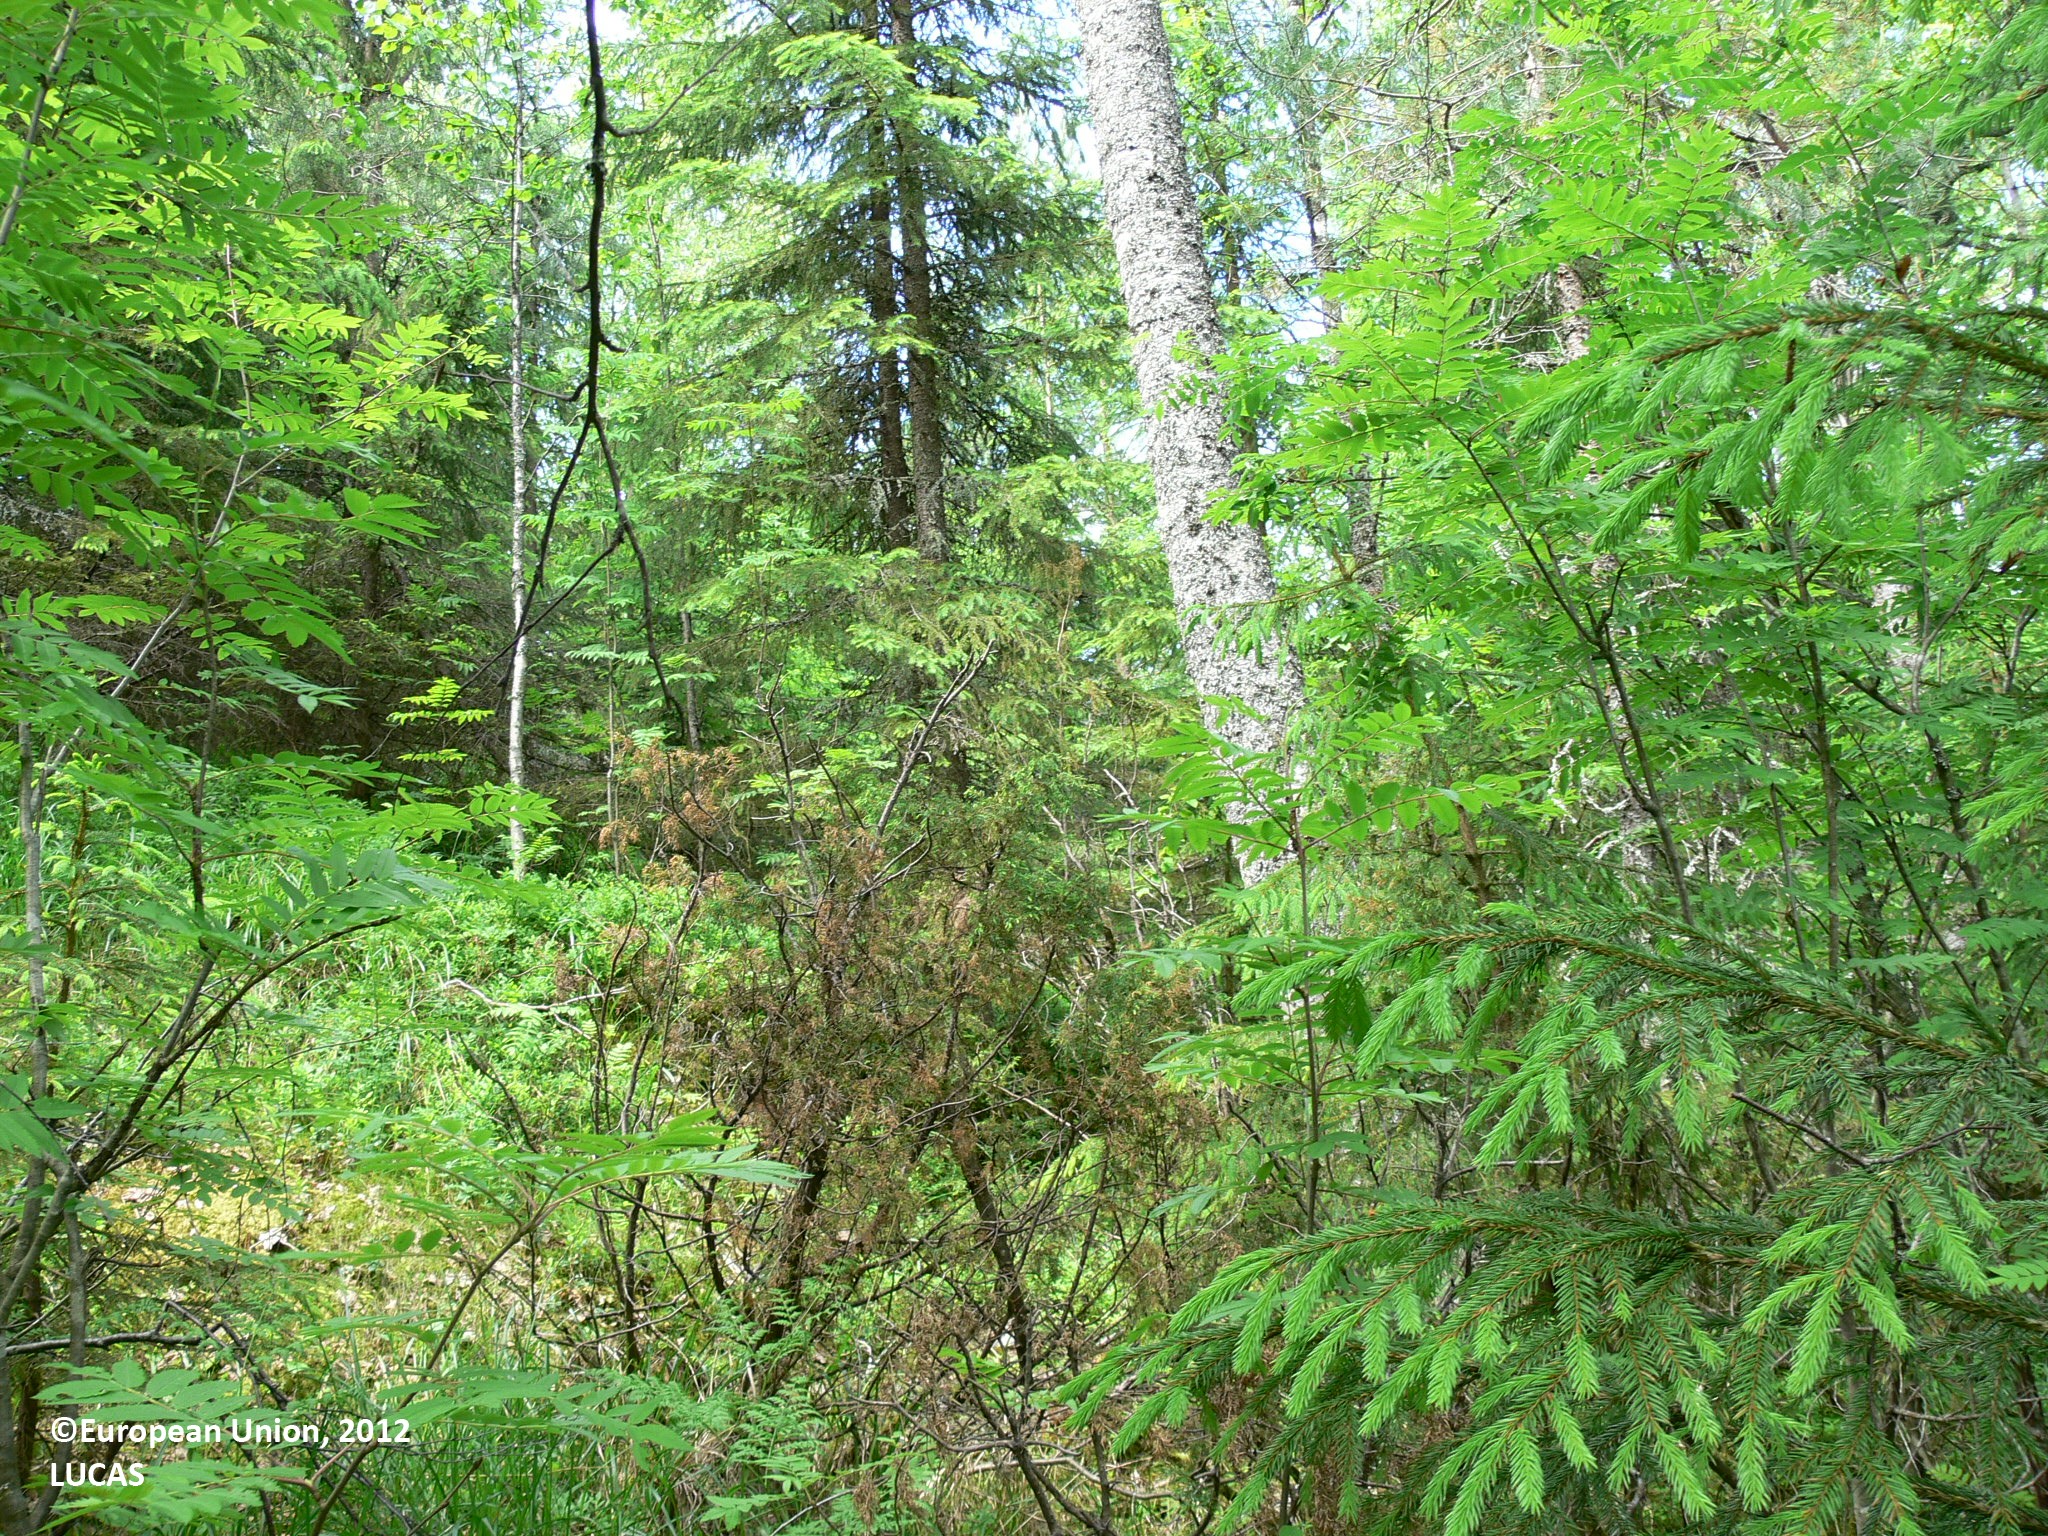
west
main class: Woodland
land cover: Spruce dominated mixed woodland
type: boreal forest
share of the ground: > 75 %
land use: Forestry
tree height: > 5 m
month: June
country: FI
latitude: 62.8229
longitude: 29.9787
